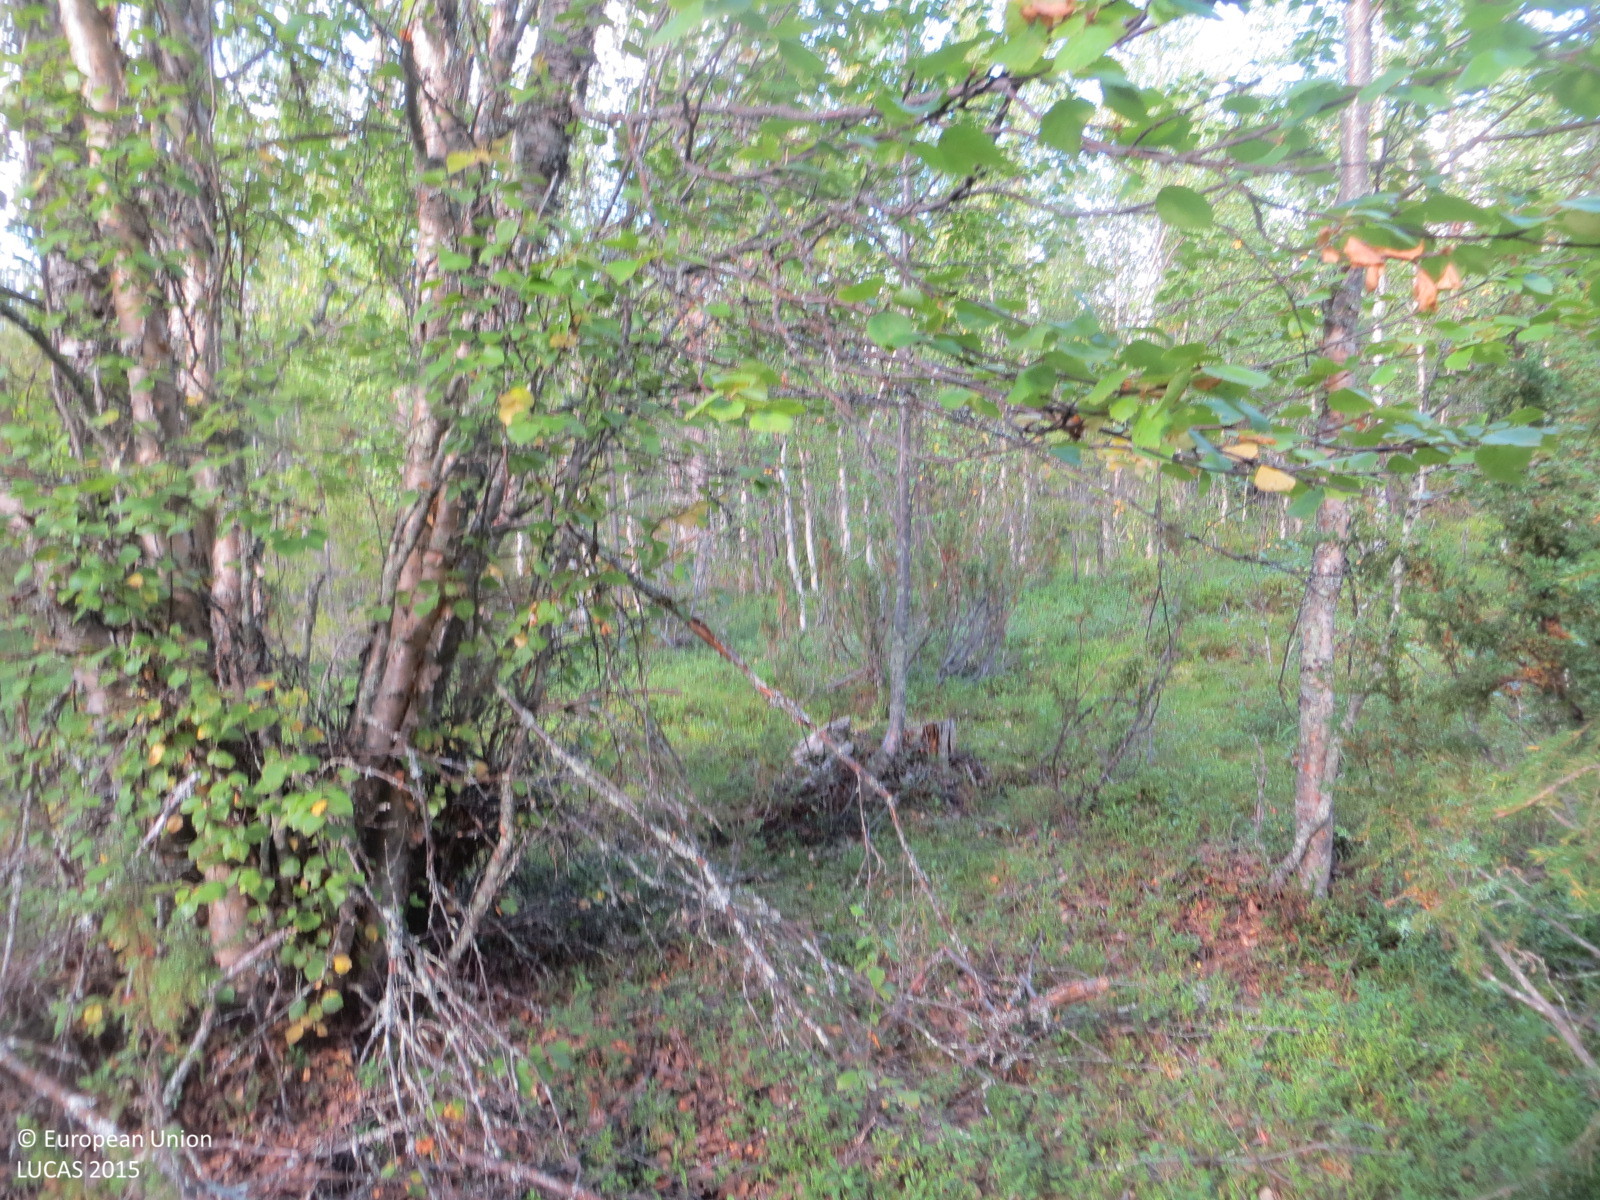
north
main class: Woodland
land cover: Pine dominated mixed woodland
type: boreal forest
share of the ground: 50 - 75 %
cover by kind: shrubs 40 %, coniferous forest trees 30 %, broadleaved forest trees 30 %
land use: Forestry
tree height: > 5 m
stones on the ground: 25 - 50 %
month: August
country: FI
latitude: 68.0204
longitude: 25.7274
